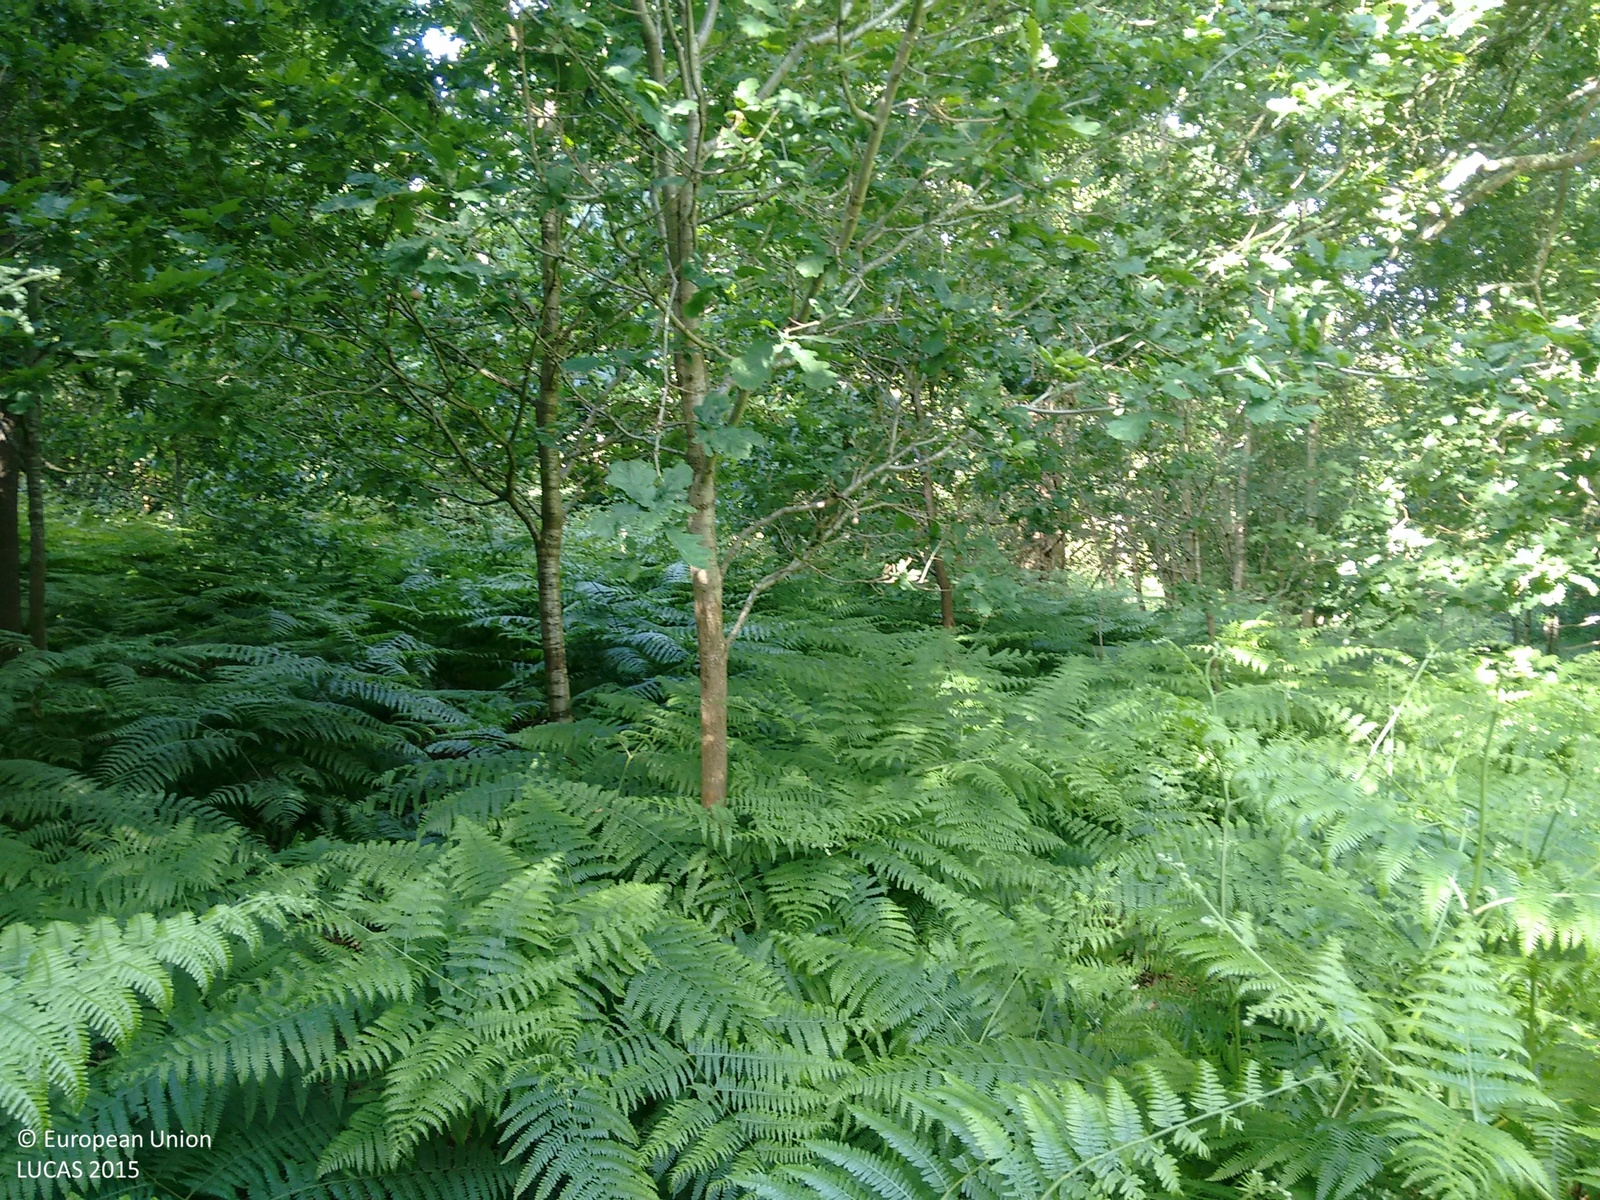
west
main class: Woodland
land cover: Broadleaved woodland
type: mesophytic deciduous forest
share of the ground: 50 - 75 %
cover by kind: broadleaved forest trees 70 %, herbaceous plants 20 %, shrubs 10 %
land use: Forestry
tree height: > 5 m
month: June
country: GB
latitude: 50.9012
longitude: 0.4016
